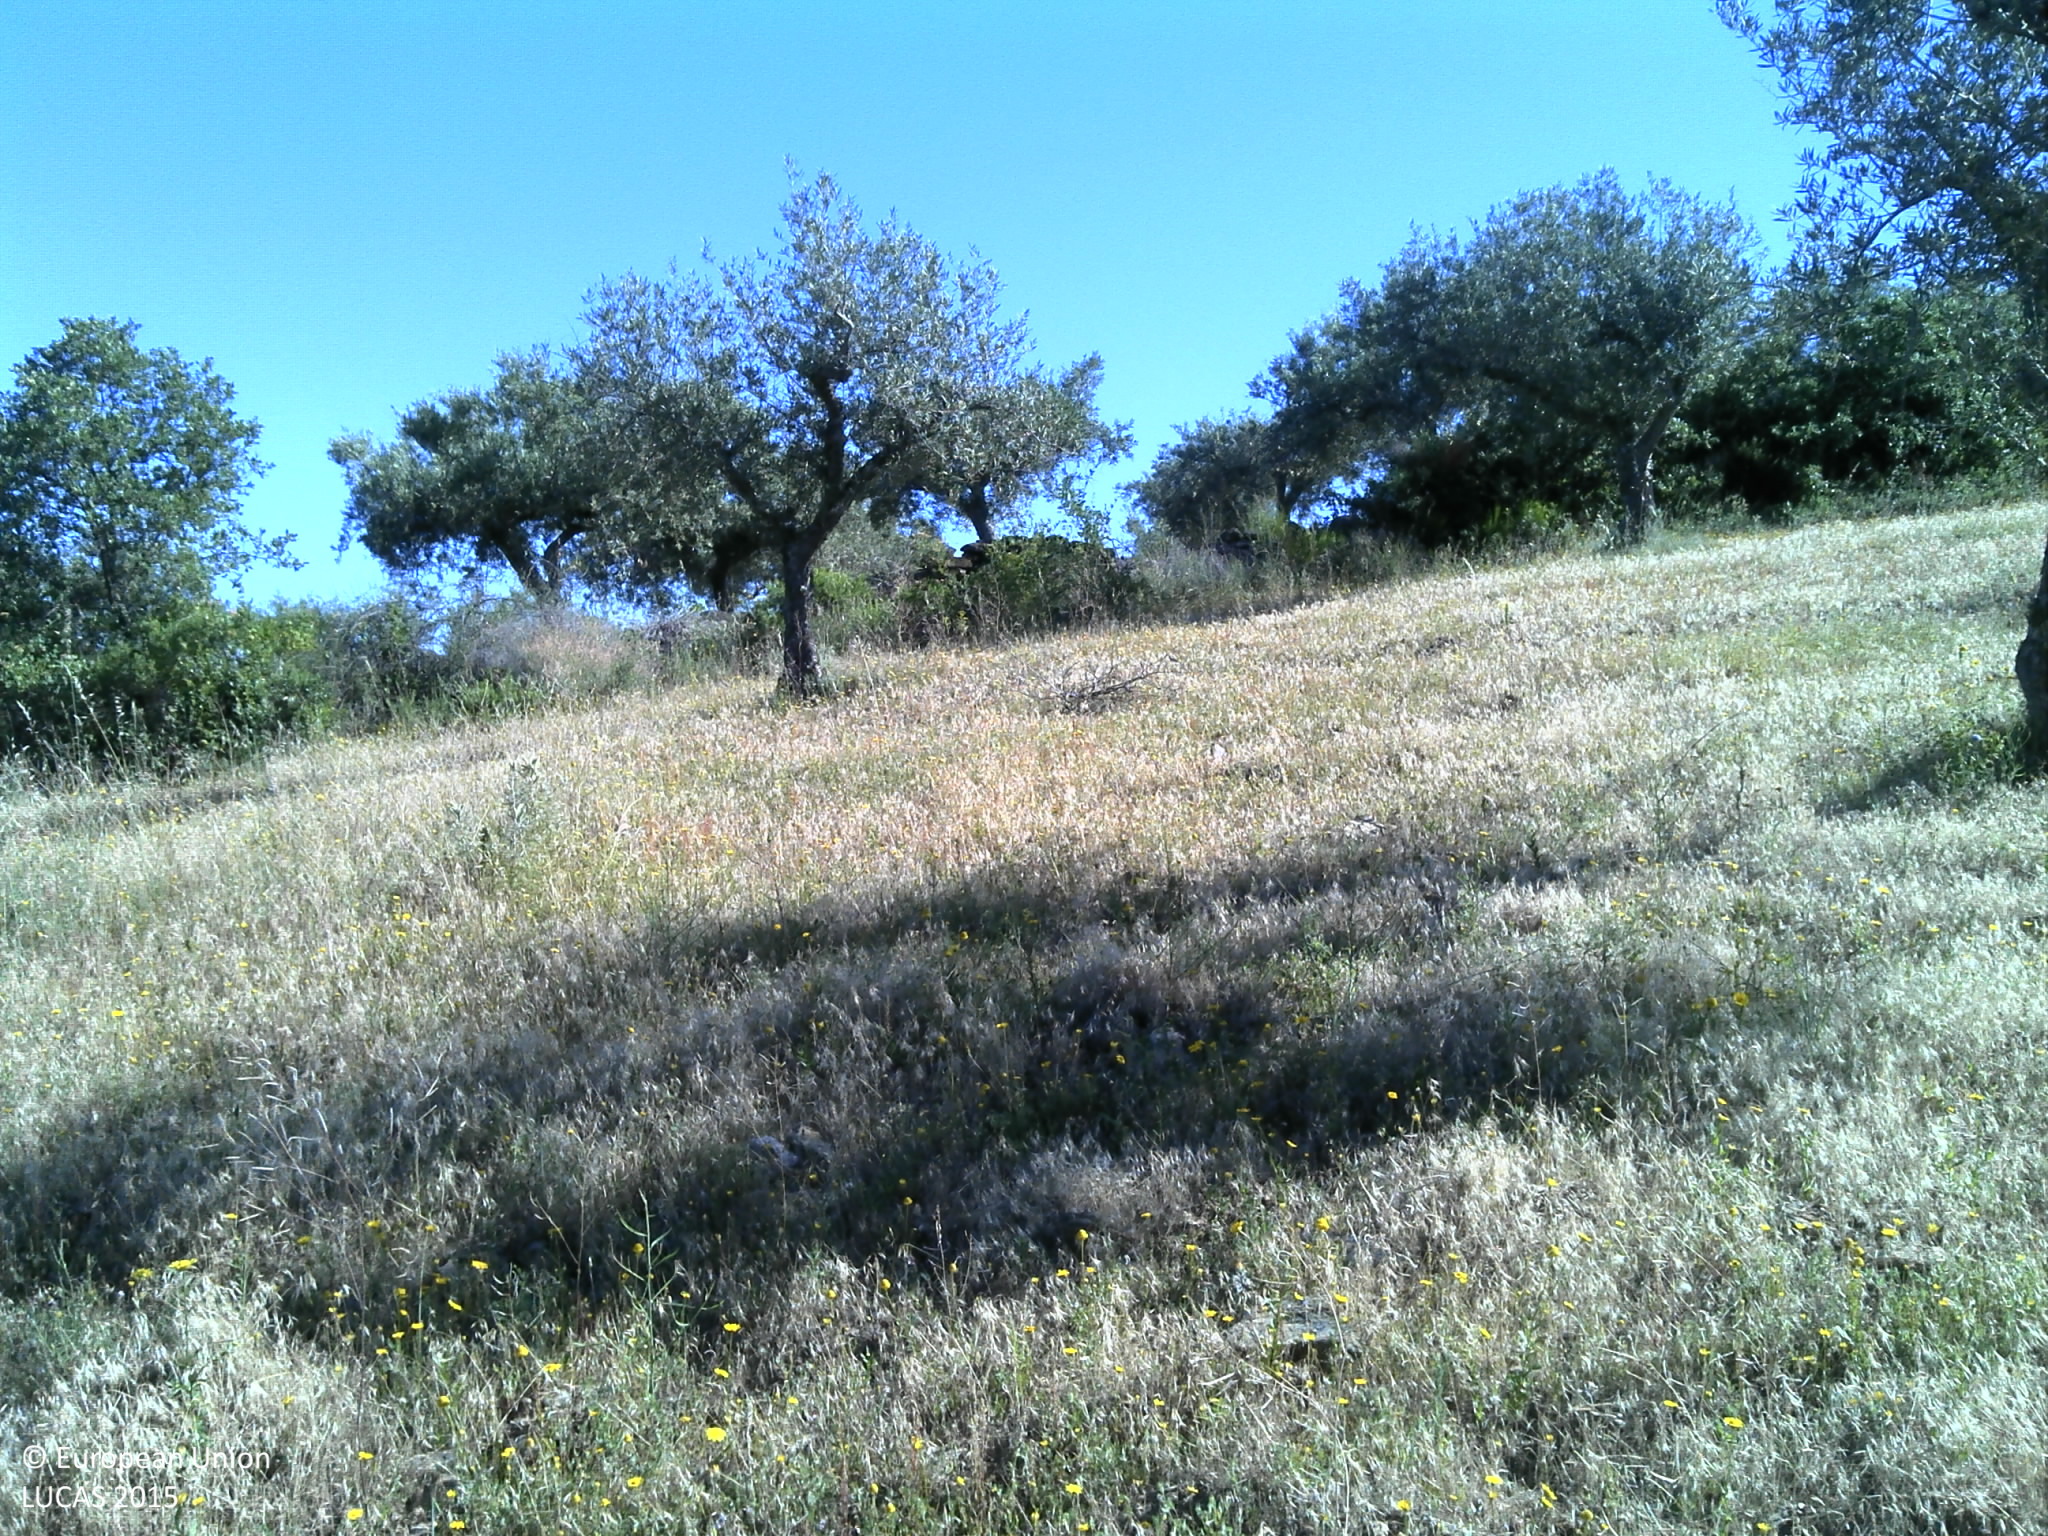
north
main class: Cropland
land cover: Olive groves
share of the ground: 25 - 50 %
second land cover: Grassland without tree/shrub cover
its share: 50 - 75 %
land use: Agriculture (excluding fallow land and kitchen gardens)
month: May
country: PT
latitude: 41.5678
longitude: -7.1356
